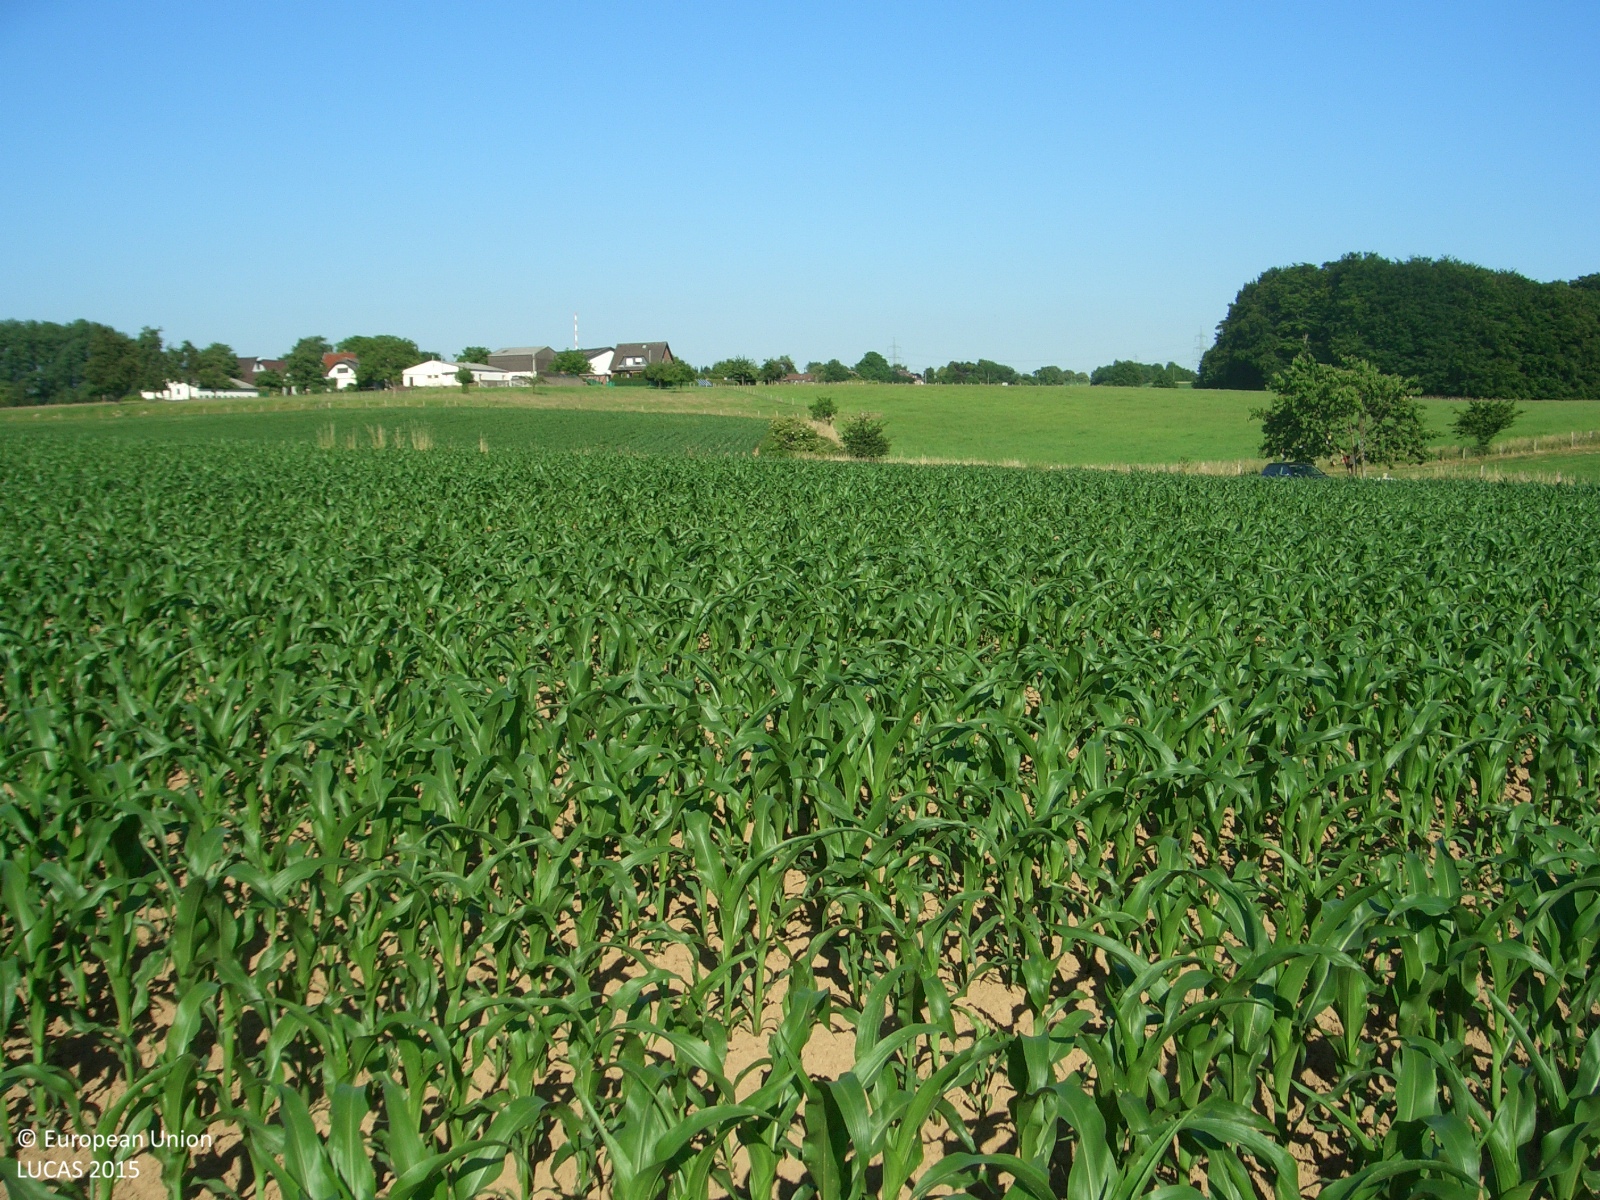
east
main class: Cropland
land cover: Maize
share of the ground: 50 - 75 %
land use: Agriculture (excluding fallow land and kitchen gardens)
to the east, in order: Maize; Grass margins; Paved roads, cycling and walking lanes; Grass margins; Maize; Grass margins; Fences; Grassland without tree/shrub cover
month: June
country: DE
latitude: 51.1175
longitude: 7.0428
